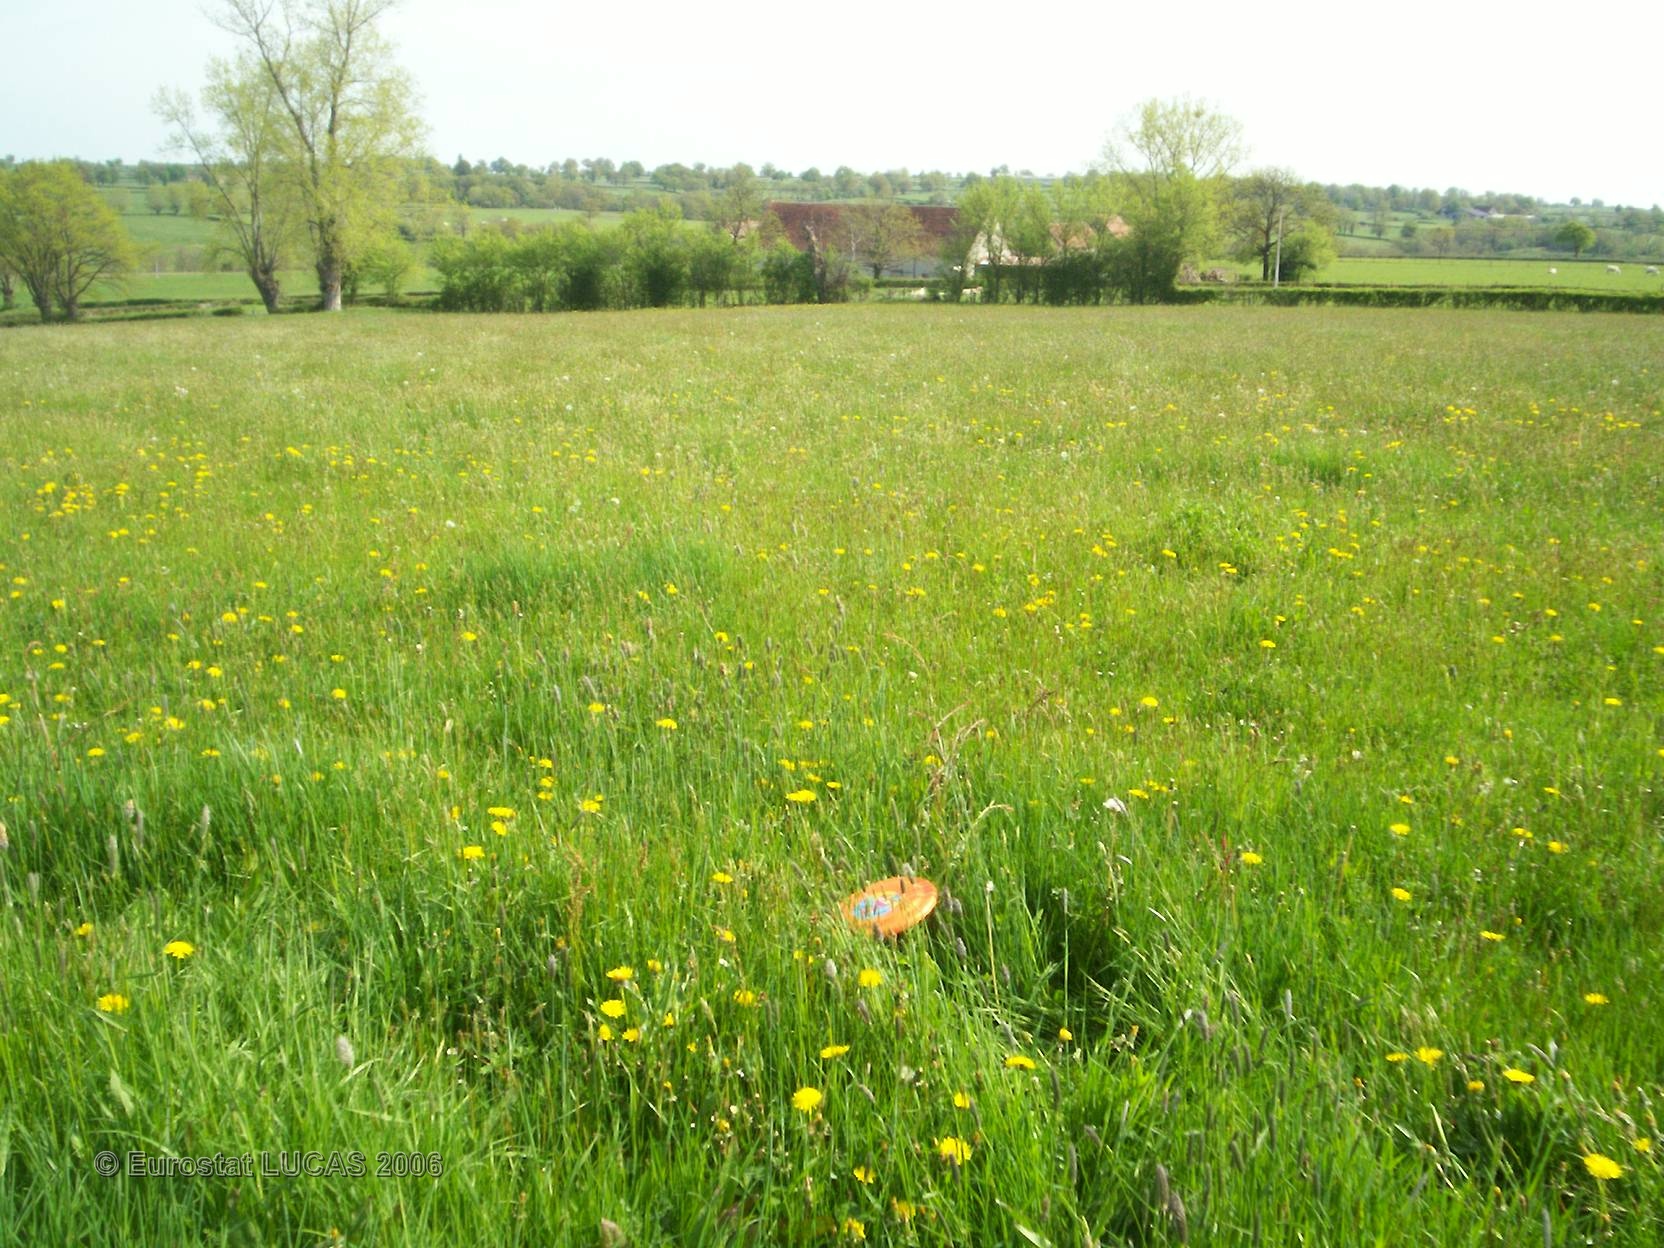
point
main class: Grassland
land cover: Grassland without tree/shrub cover
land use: Agriculture (excluding fallow land and kitchen gardens)
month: May
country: FR
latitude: 46.3321
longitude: 3.1783
